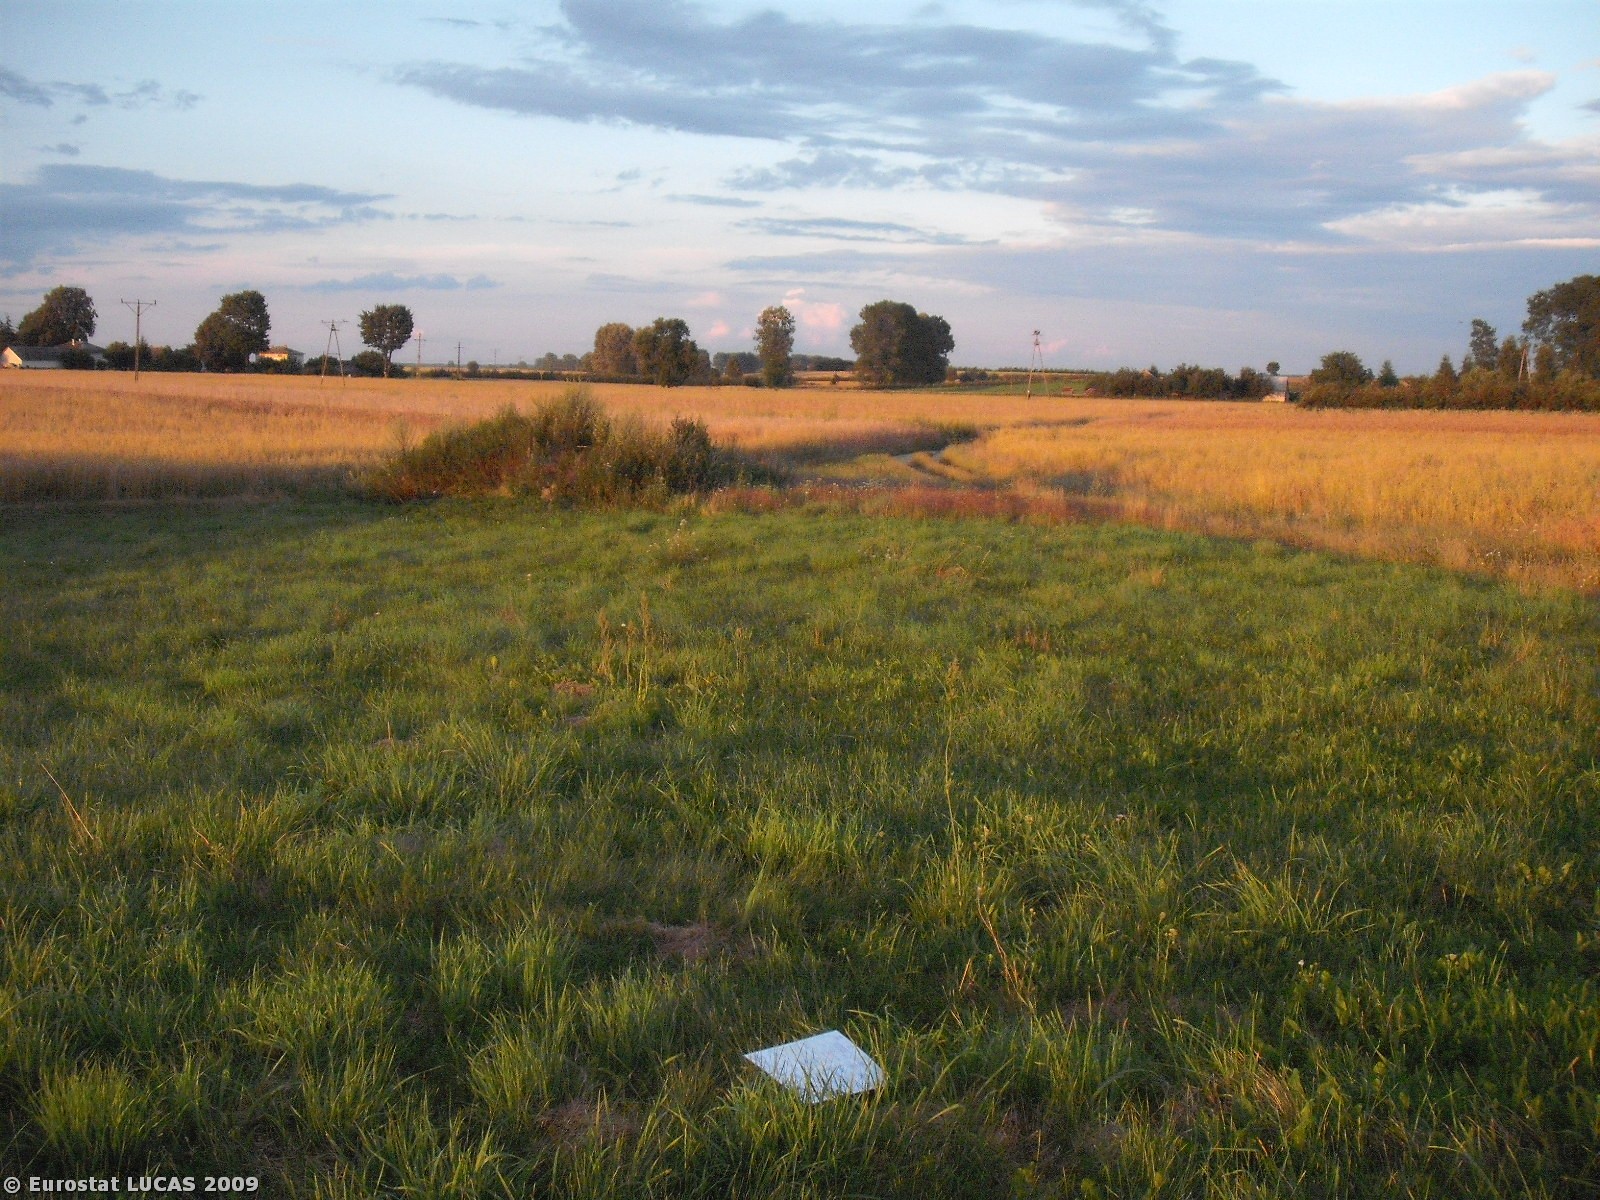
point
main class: Grassland
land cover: Grassland without tree/shrub cover
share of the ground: > 75 %
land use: Agriculture (excluding fallow land and kitchen gardens)
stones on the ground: < 10 %
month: July
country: PL
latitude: 51.1321
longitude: 21.4397
